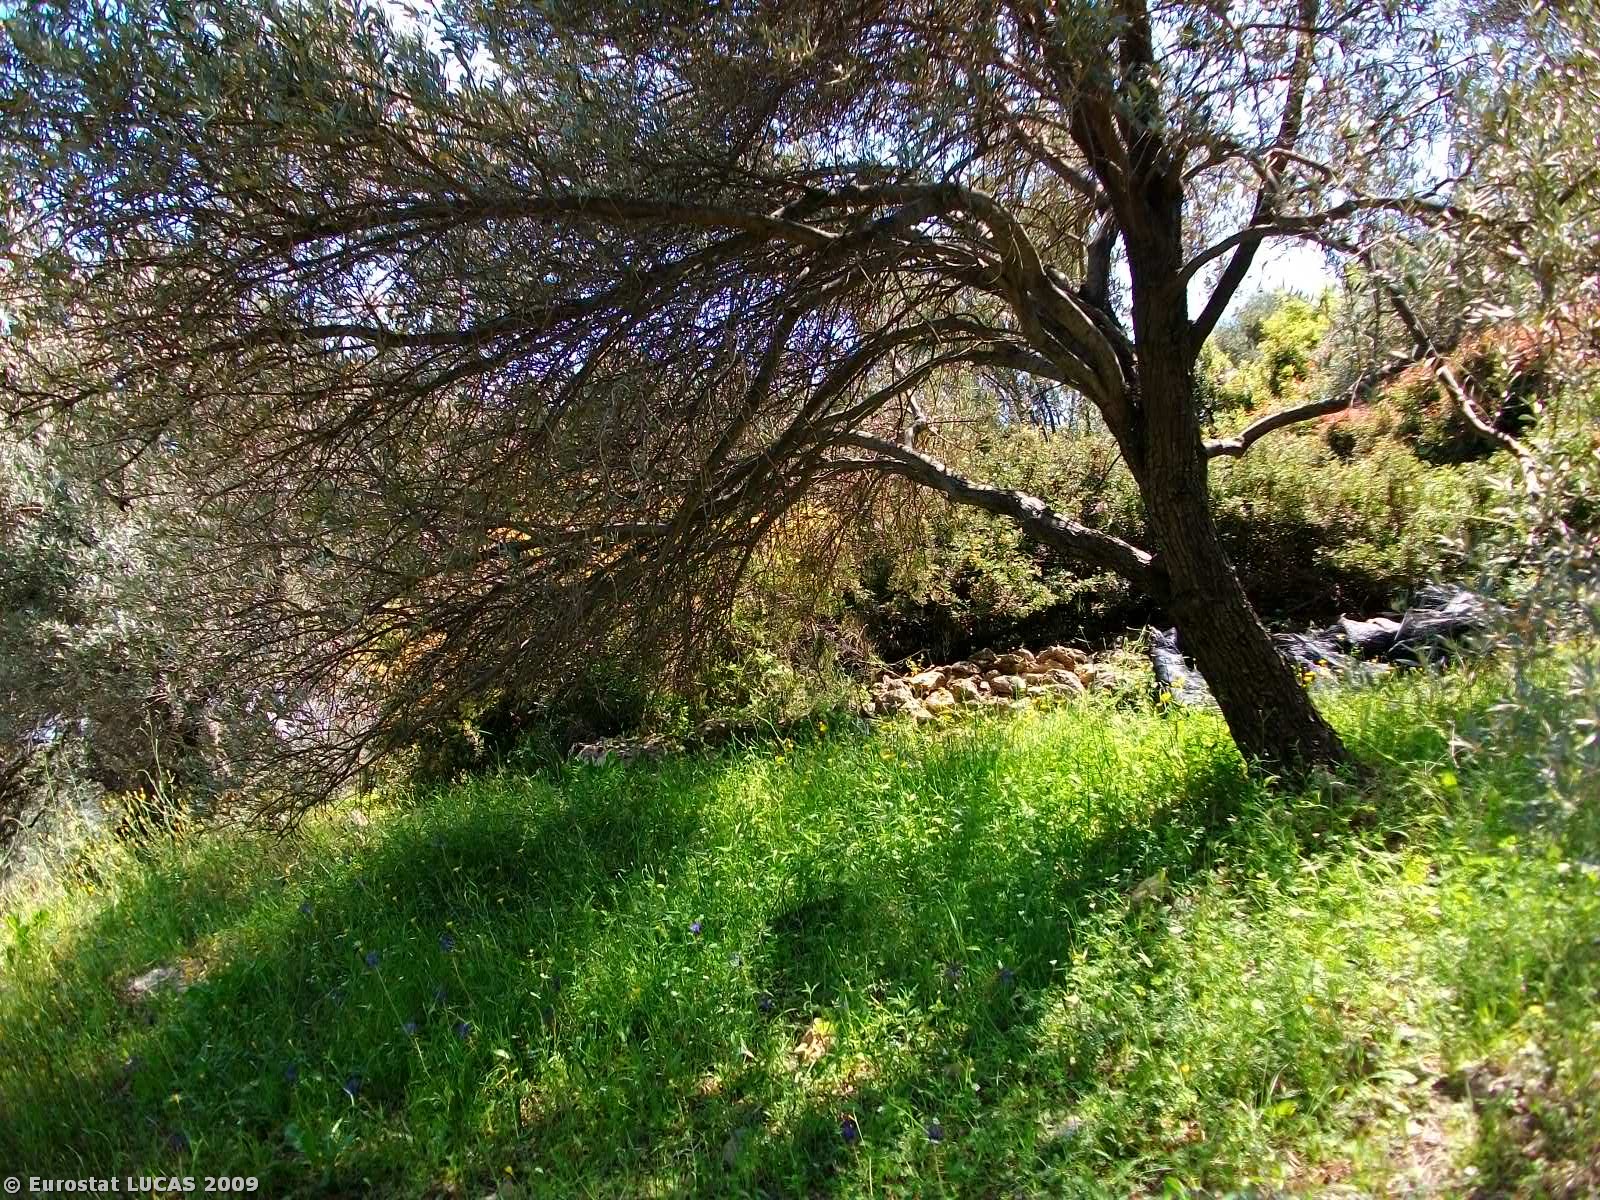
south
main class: Cropland
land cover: Olive groves
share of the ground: 50 - 75 %
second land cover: Grassland with sparse tree/shrub cover
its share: > 75 %
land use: Agriculture (excluding fallow land and kitchen gardens)
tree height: < 5 m
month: April
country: GR
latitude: 35.2973
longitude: 25.0016
